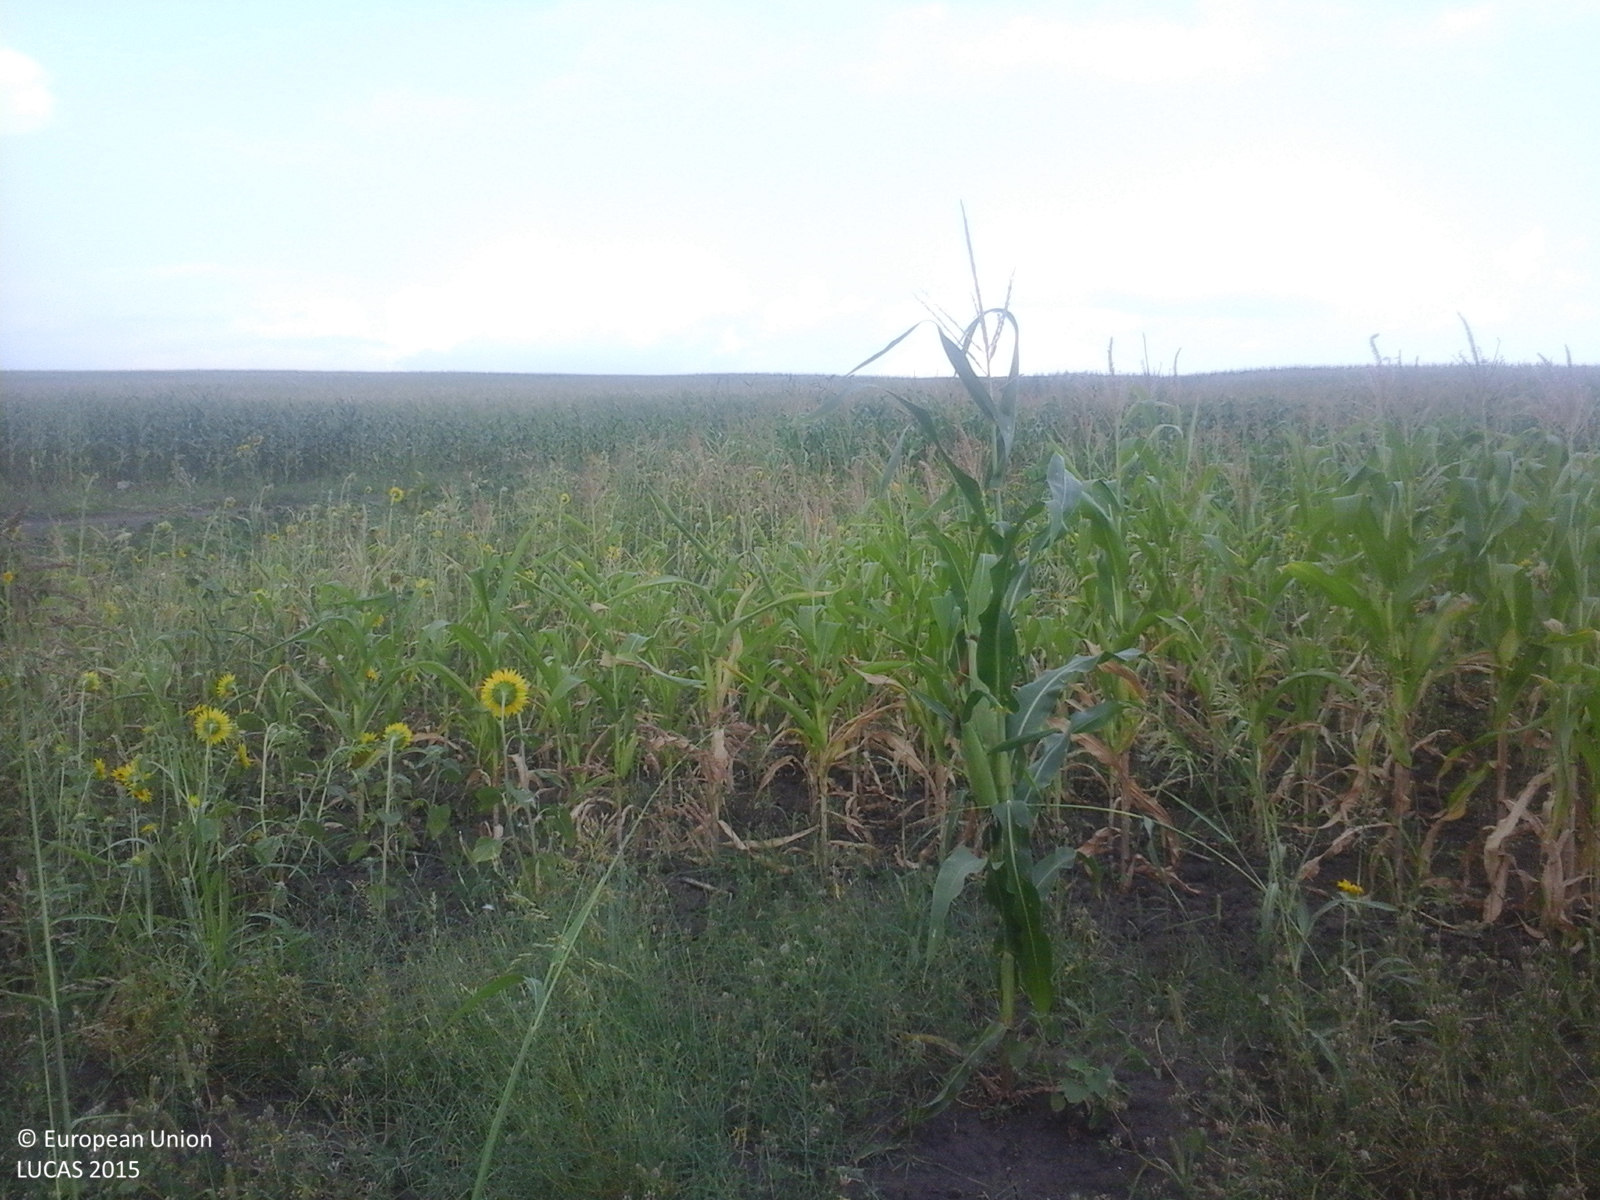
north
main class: Cropland
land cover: Maize
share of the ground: > 75 %
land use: Agriculture (excluding fallow land and kitchen gardens)
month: July
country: RO
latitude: 45.8220
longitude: 27.9987
